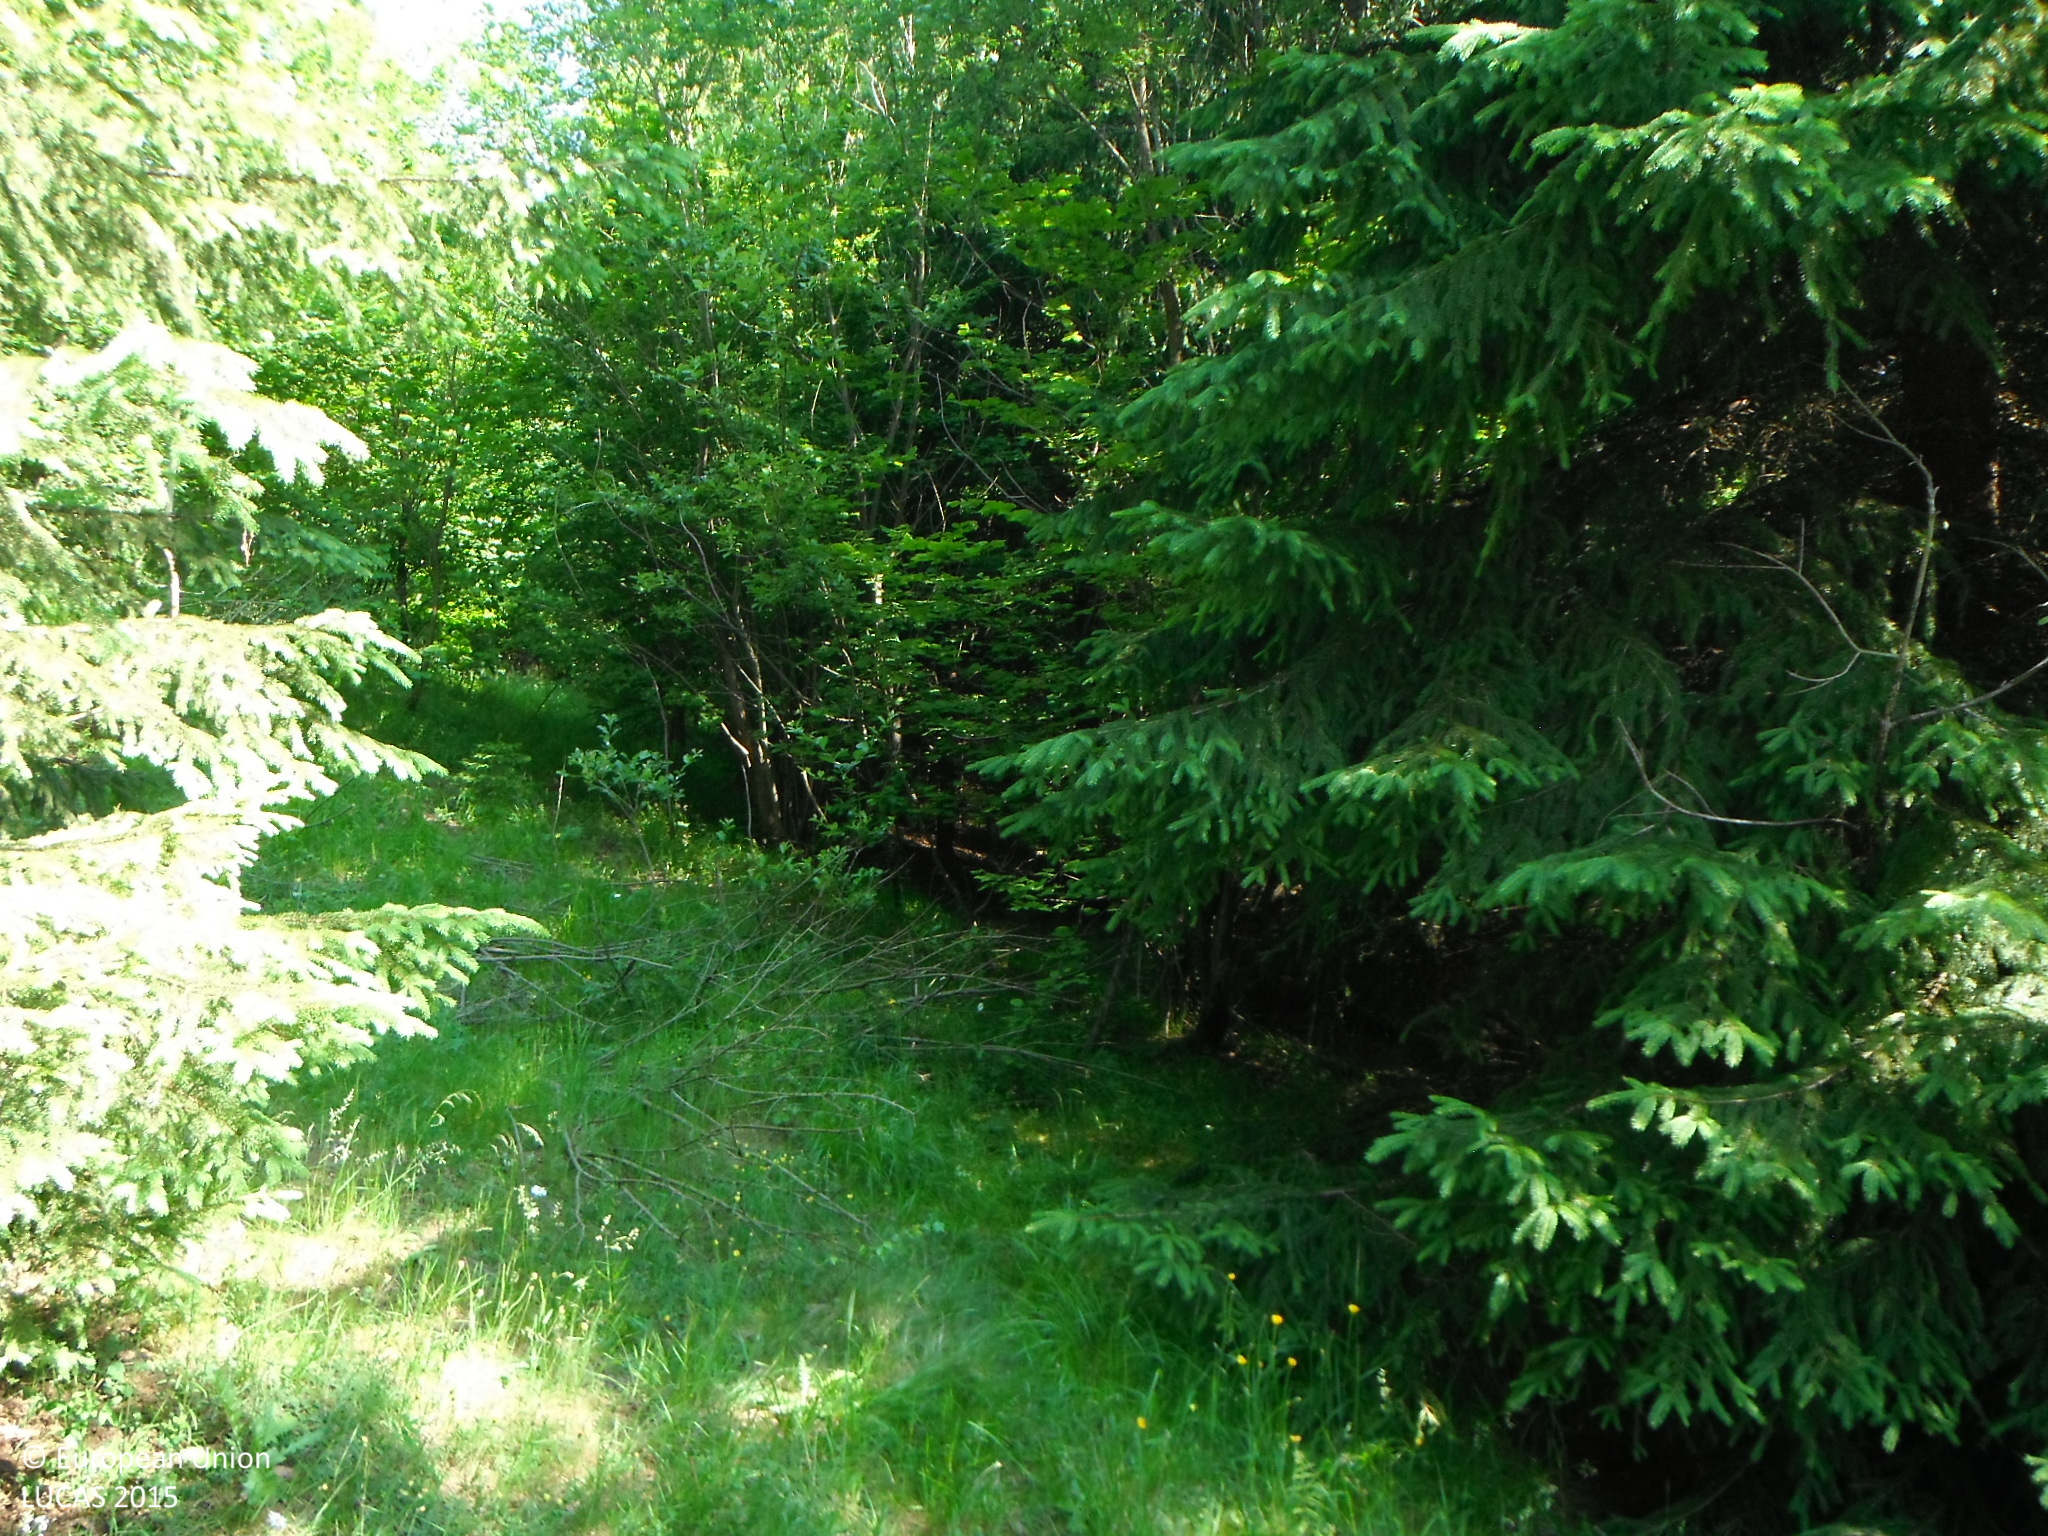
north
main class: Woodland
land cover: Spruce dominated coniferous woodland
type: alpine coniferous forest
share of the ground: > 75 %
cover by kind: coniferous forest trees 75 %, herbaceous plants 20 %, broadleaved forest trees 5 %
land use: Forestry
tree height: > 5 m
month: July
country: SK
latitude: 49.3960
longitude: 19.4090
